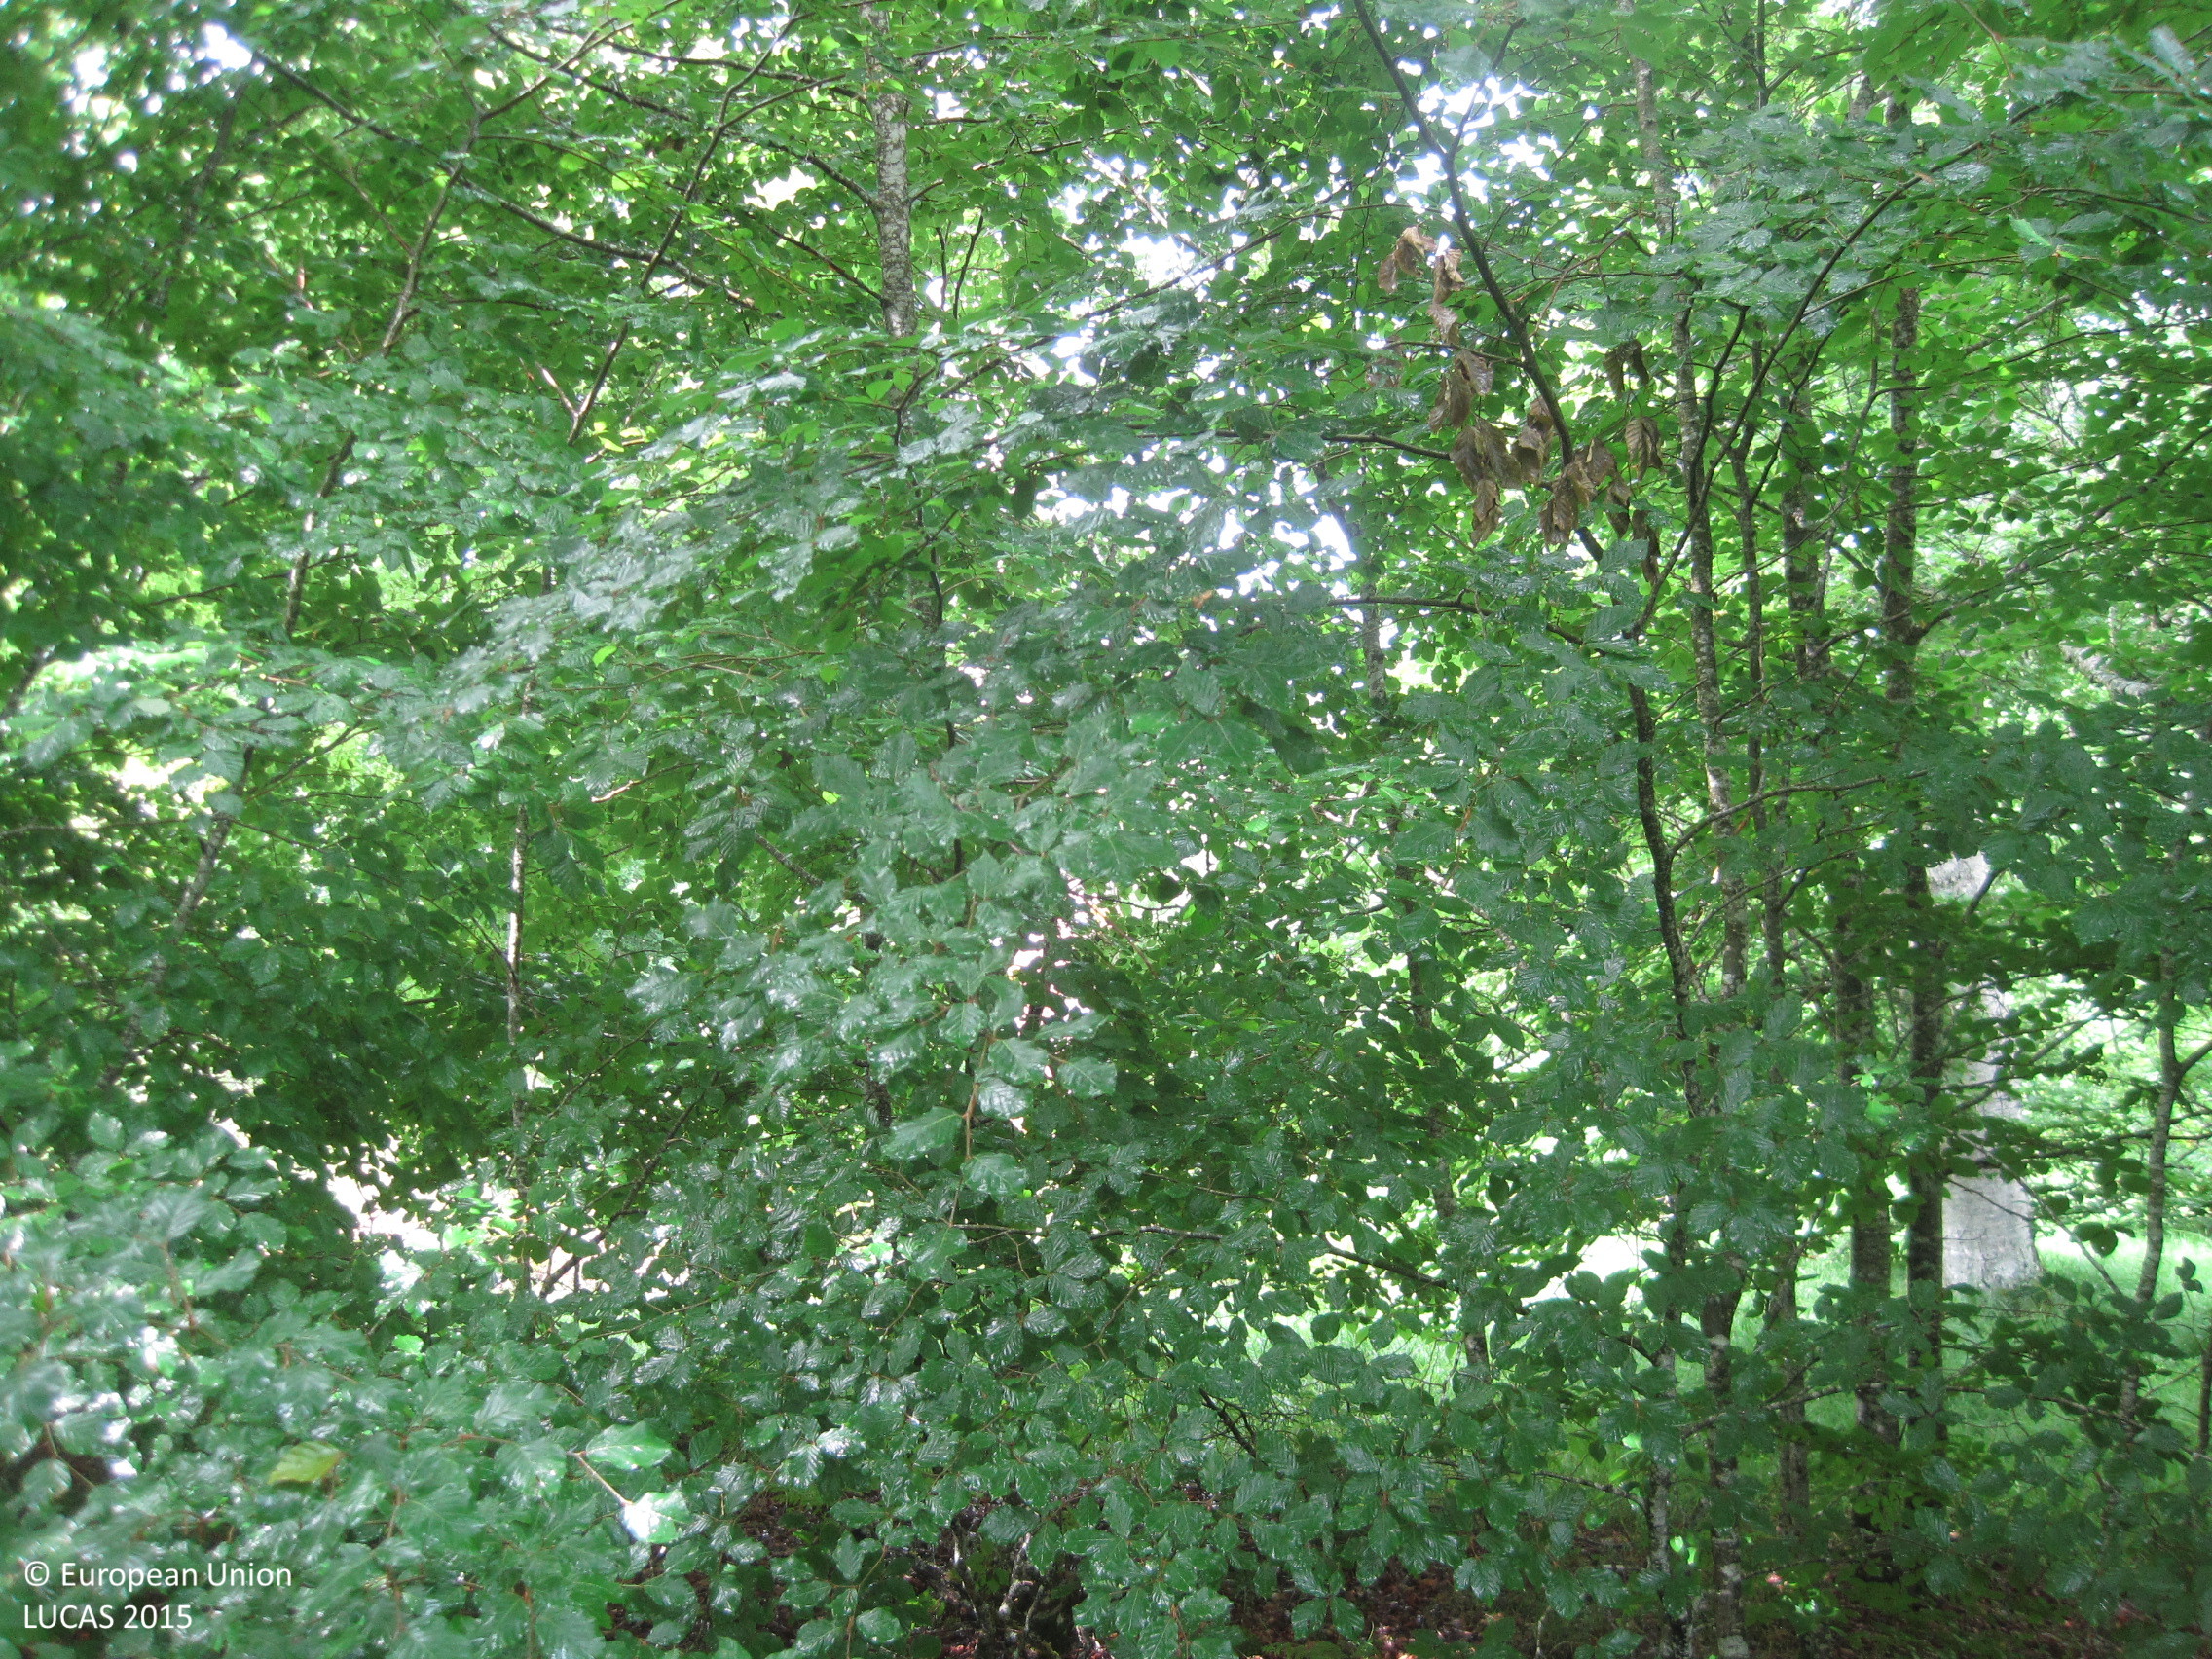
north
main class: Woodland
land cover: Broadleaved woodland
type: beech forest
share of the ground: > 75 %
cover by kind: broadleaved forest trees 95 %, herbaceous plants 5 %
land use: Forestry
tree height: > 5 m
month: June
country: ES
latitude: 42.7881
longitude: -2.2087
